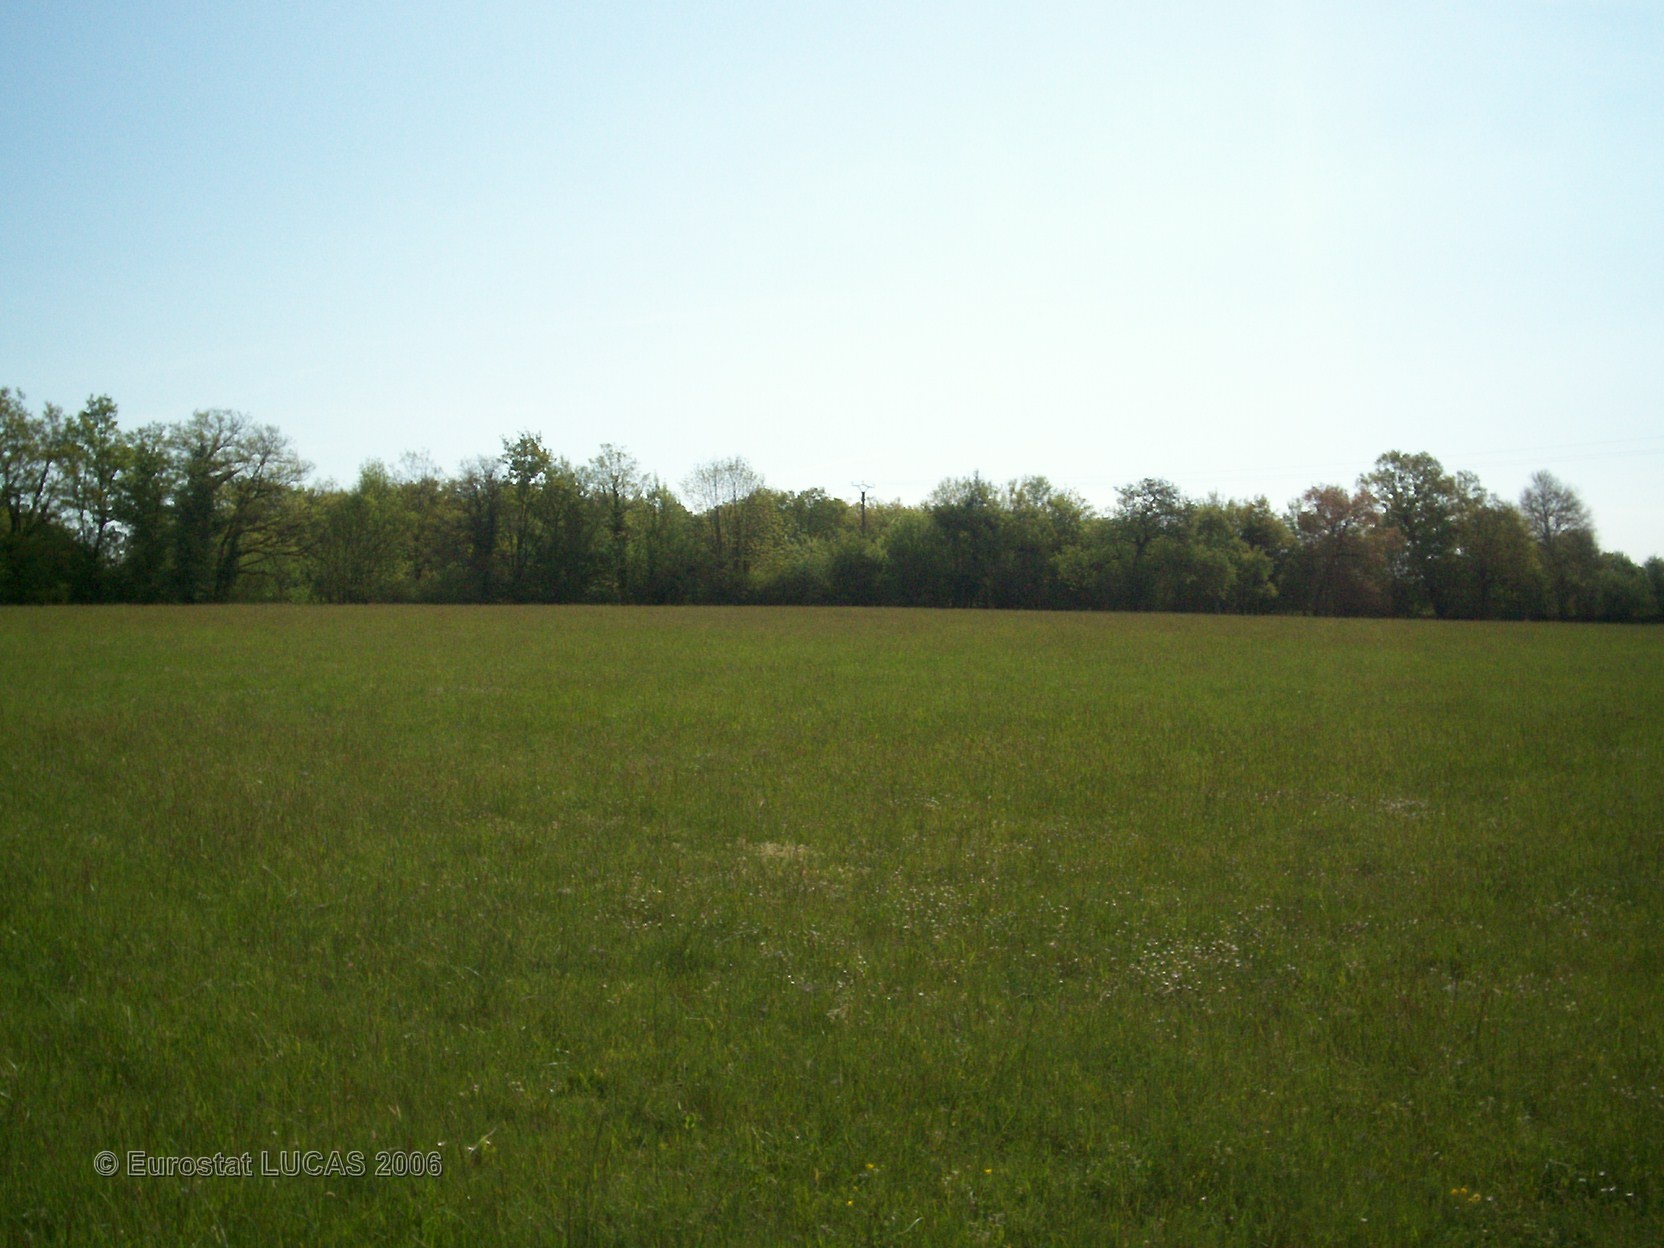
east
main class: Grassland
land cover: Grassland without tree/shrub cover
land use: Agriculture (excluding fallow land and kitchen gardens)
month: May
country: FR
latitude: 44.7504
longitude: 1.8009
